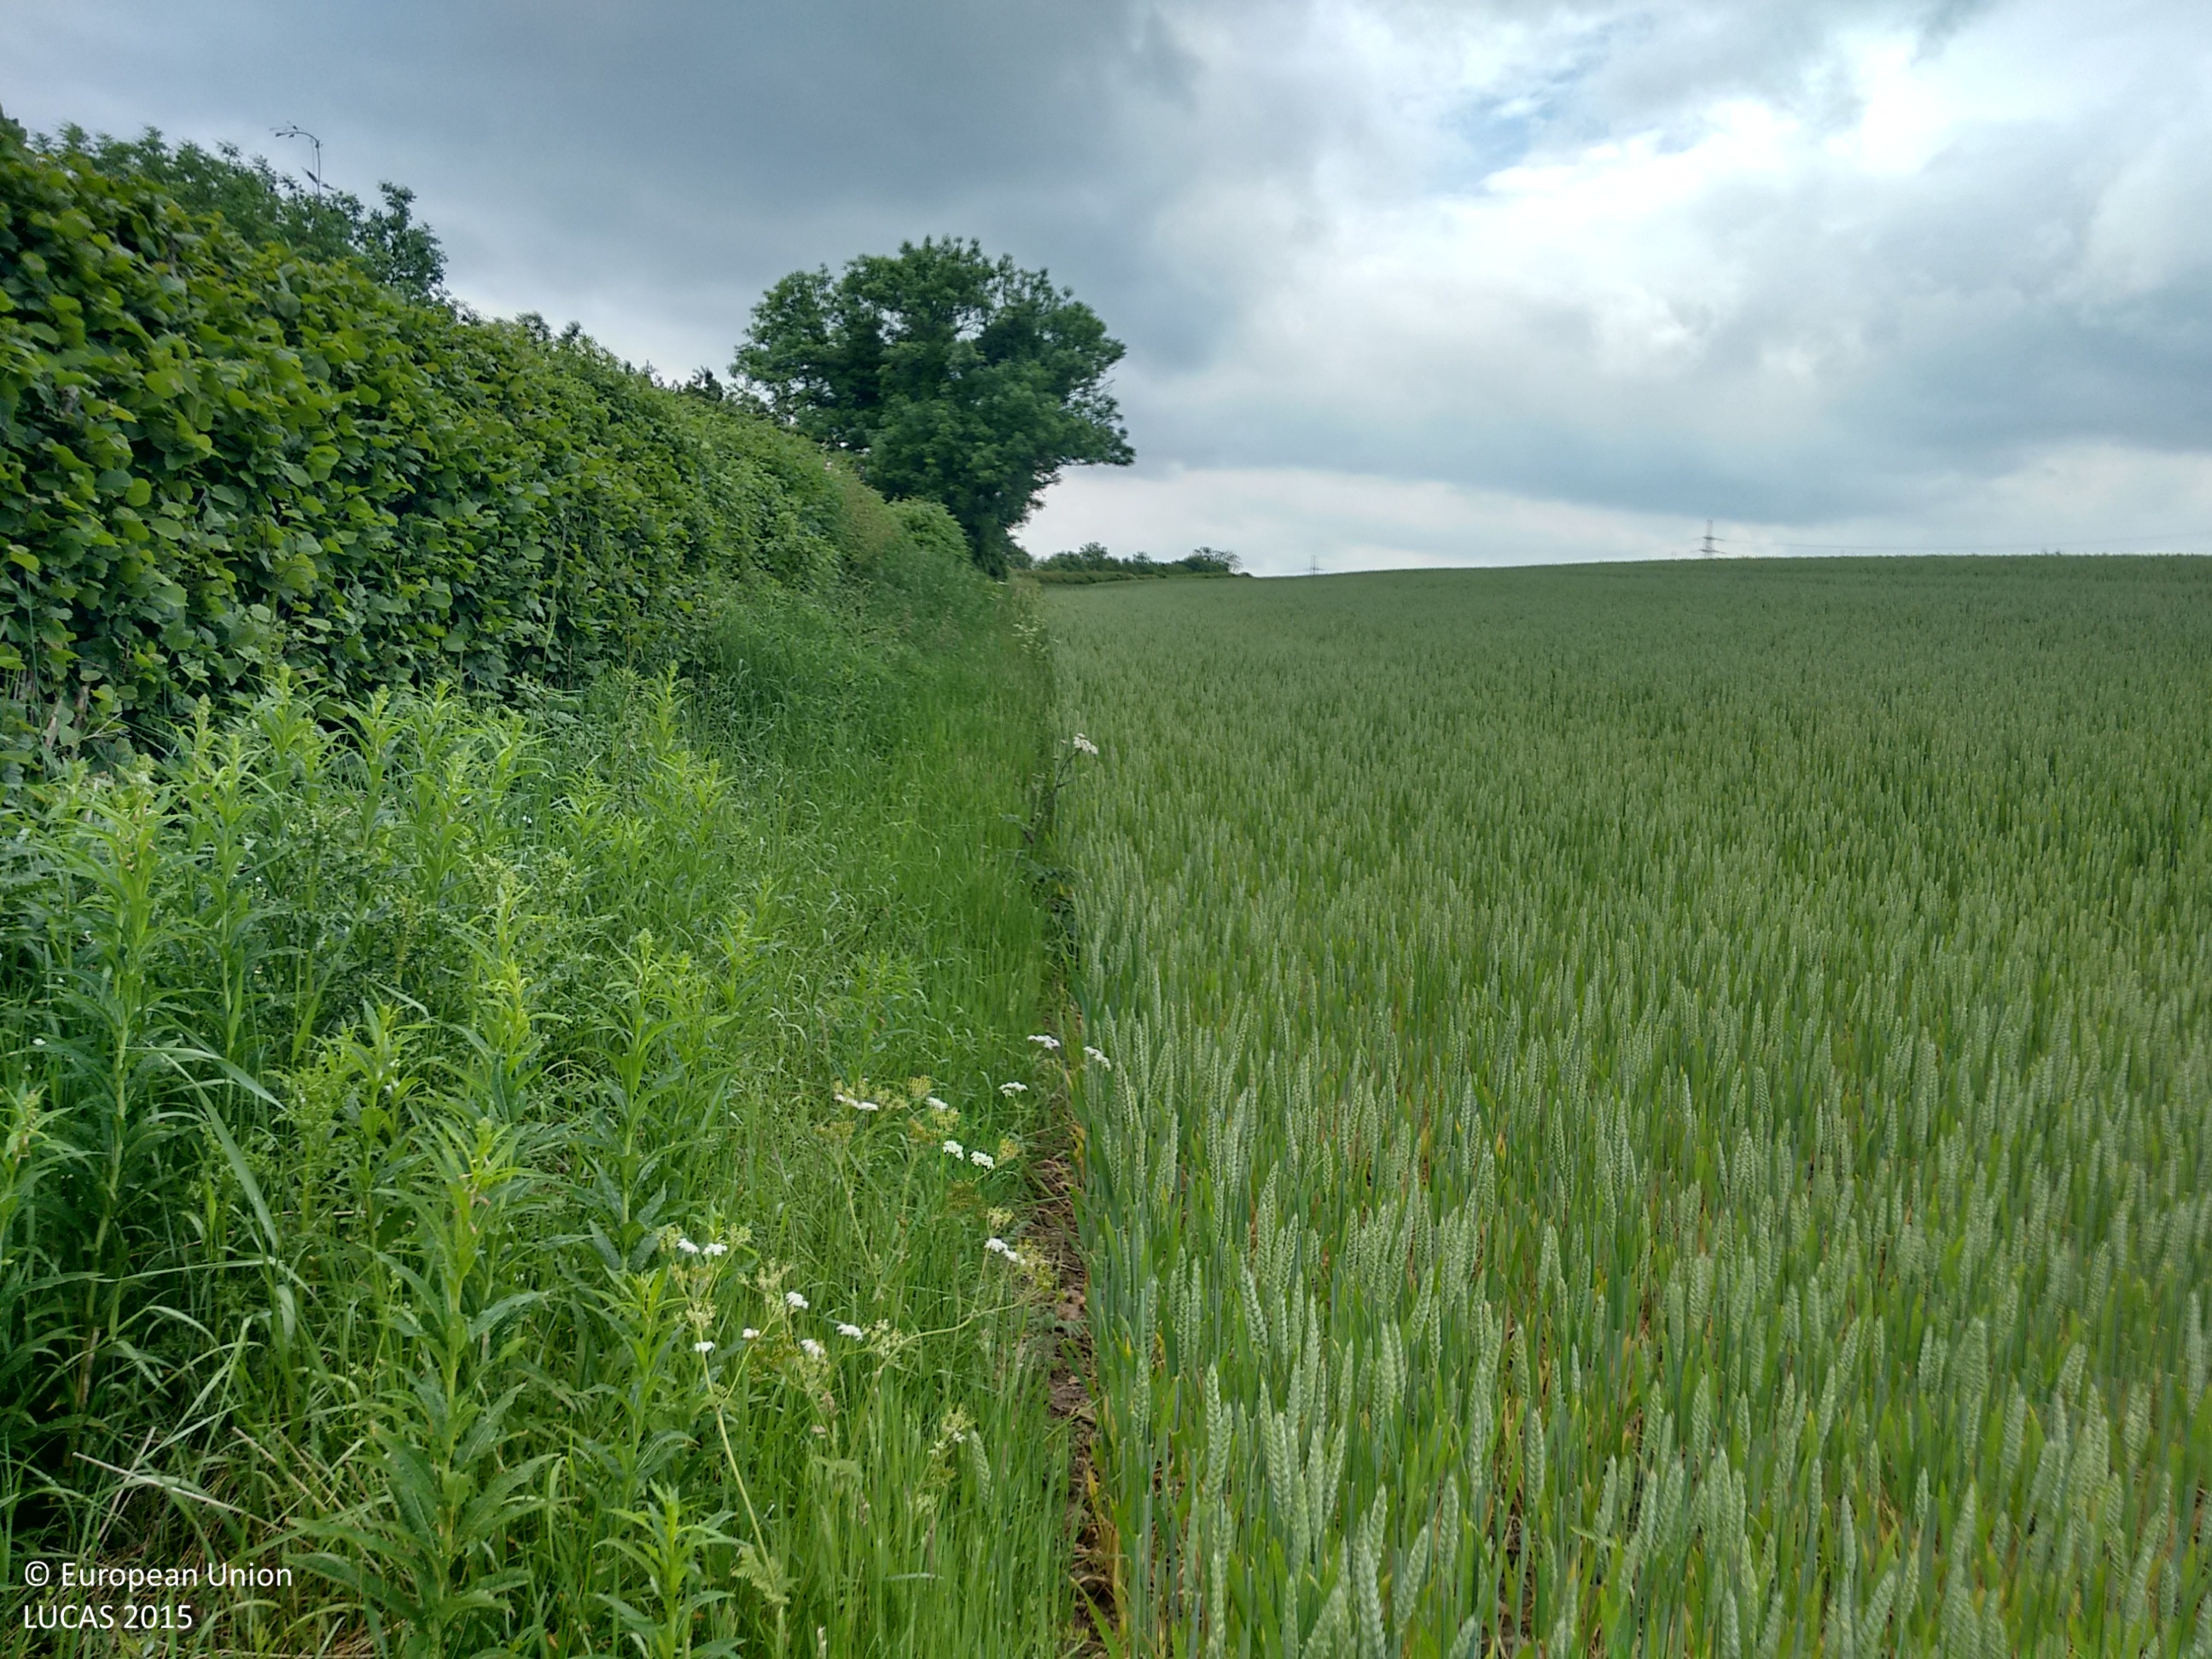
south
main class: Cropland
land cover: Common wheat
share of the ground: > 75 %
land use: Agriculture (excluding fallow land and kitchen gardens)
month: June
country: GB
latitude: 54.7187
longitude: -1.5523
